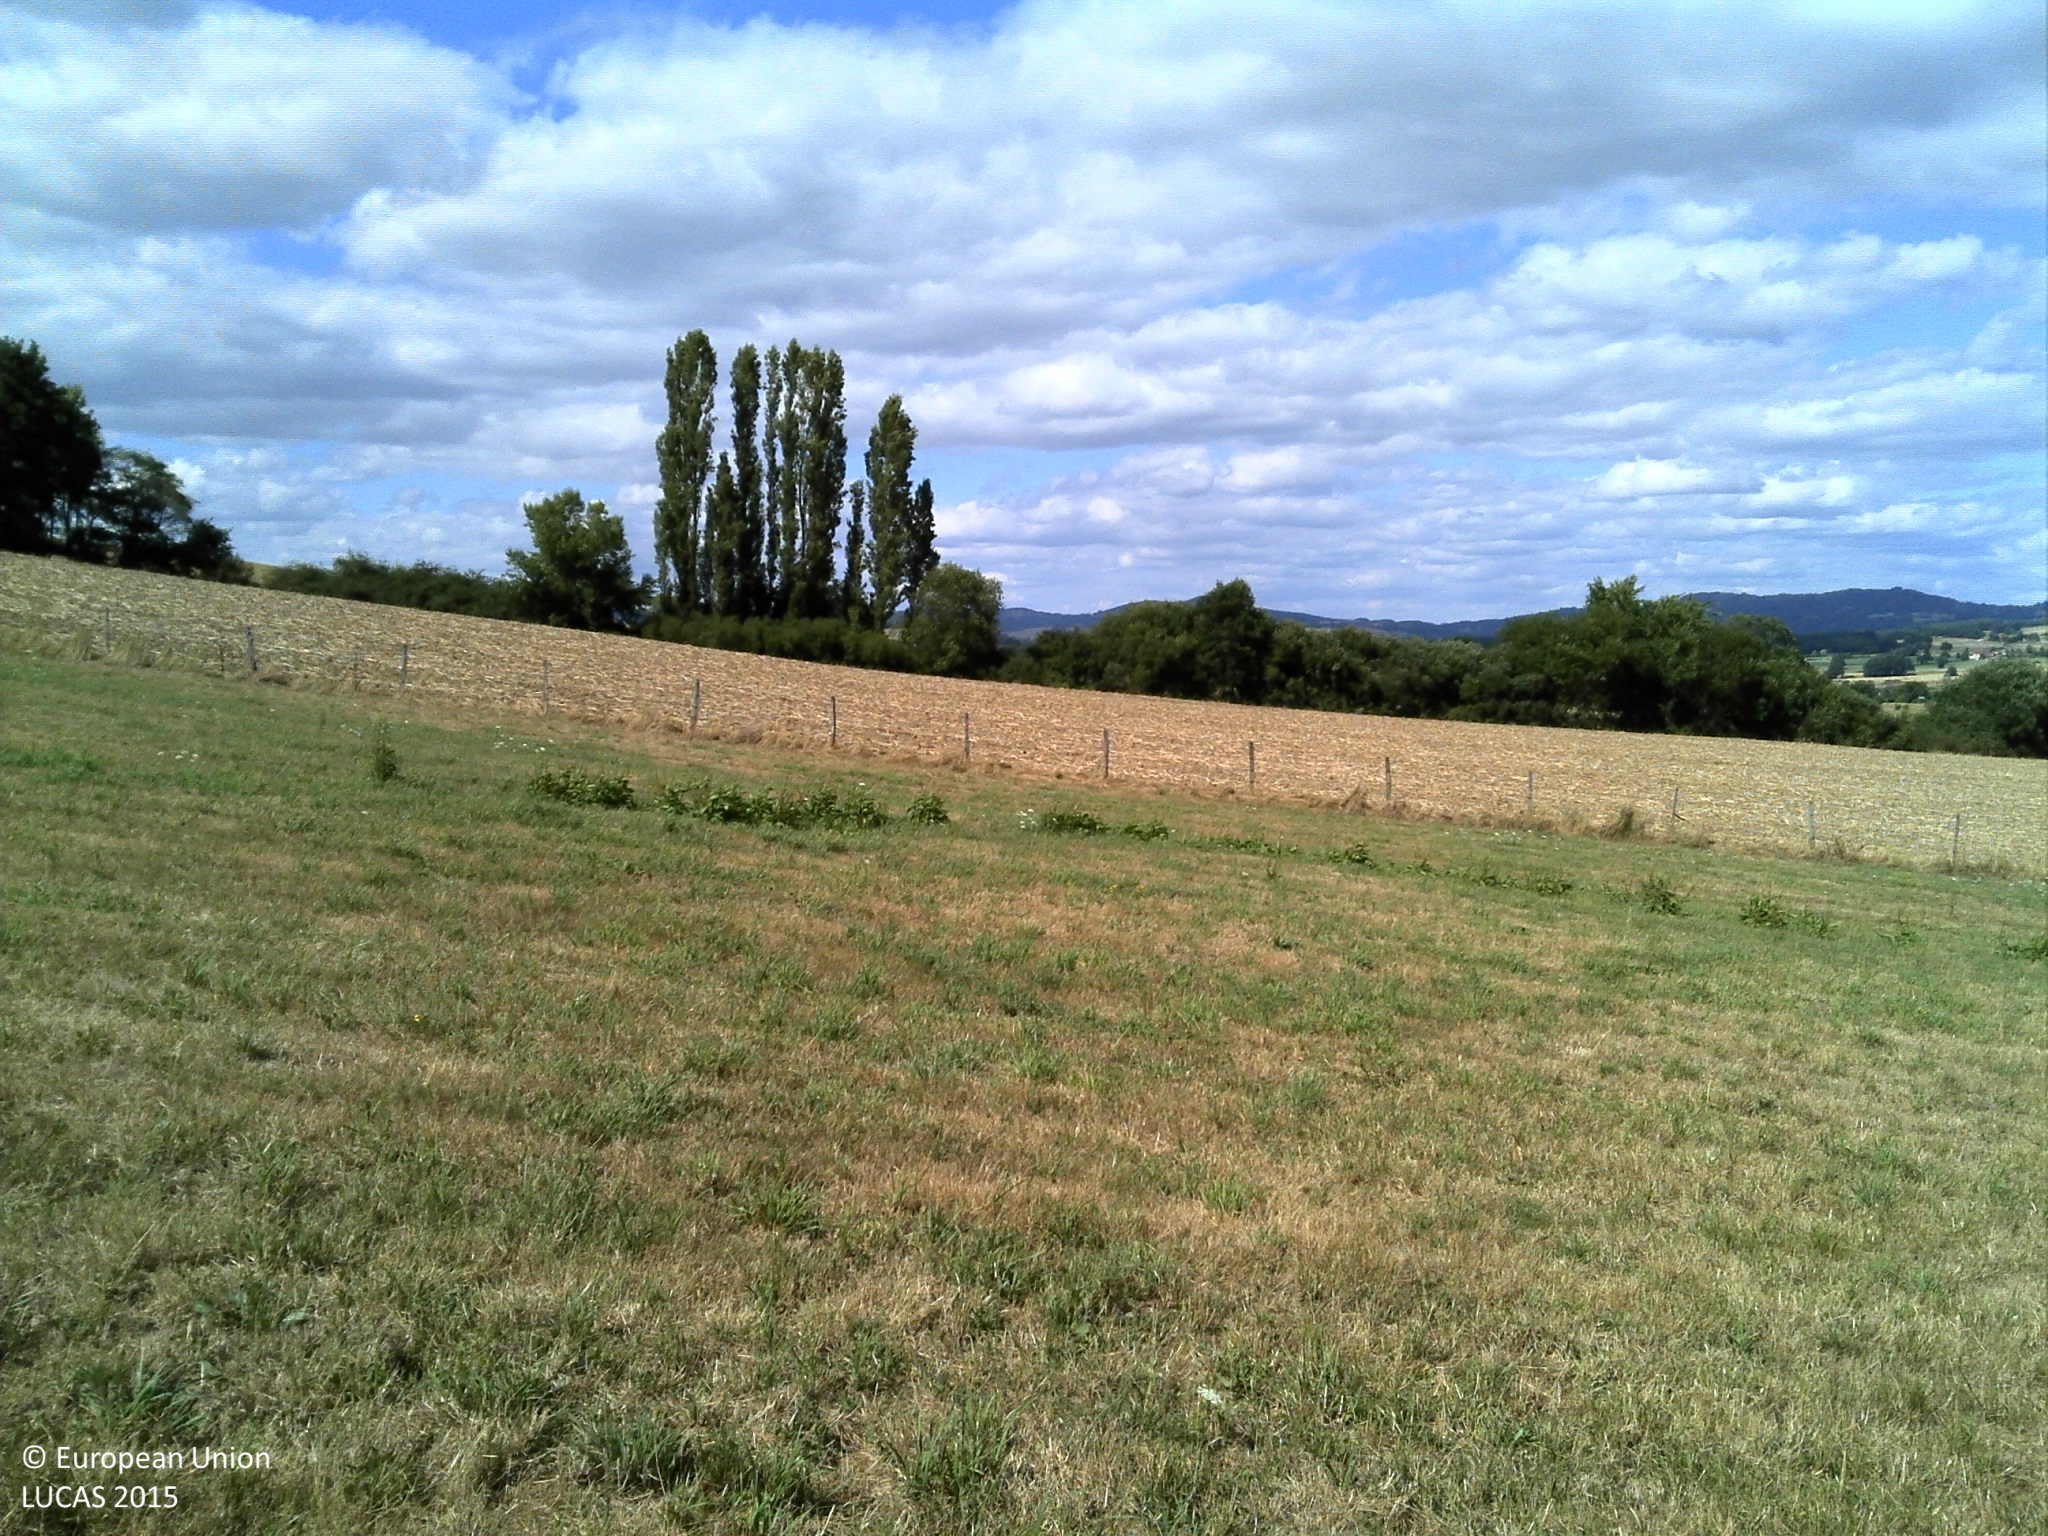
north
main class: Grassland
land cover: Grassland without tree/shrub cover
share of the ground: > 75 %
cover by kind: herbaceous plants 100 %
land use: Agriculture (excluding fallow land and kitchen gardens)
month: July
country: FR
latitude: 45.5480
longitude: 3.3536
